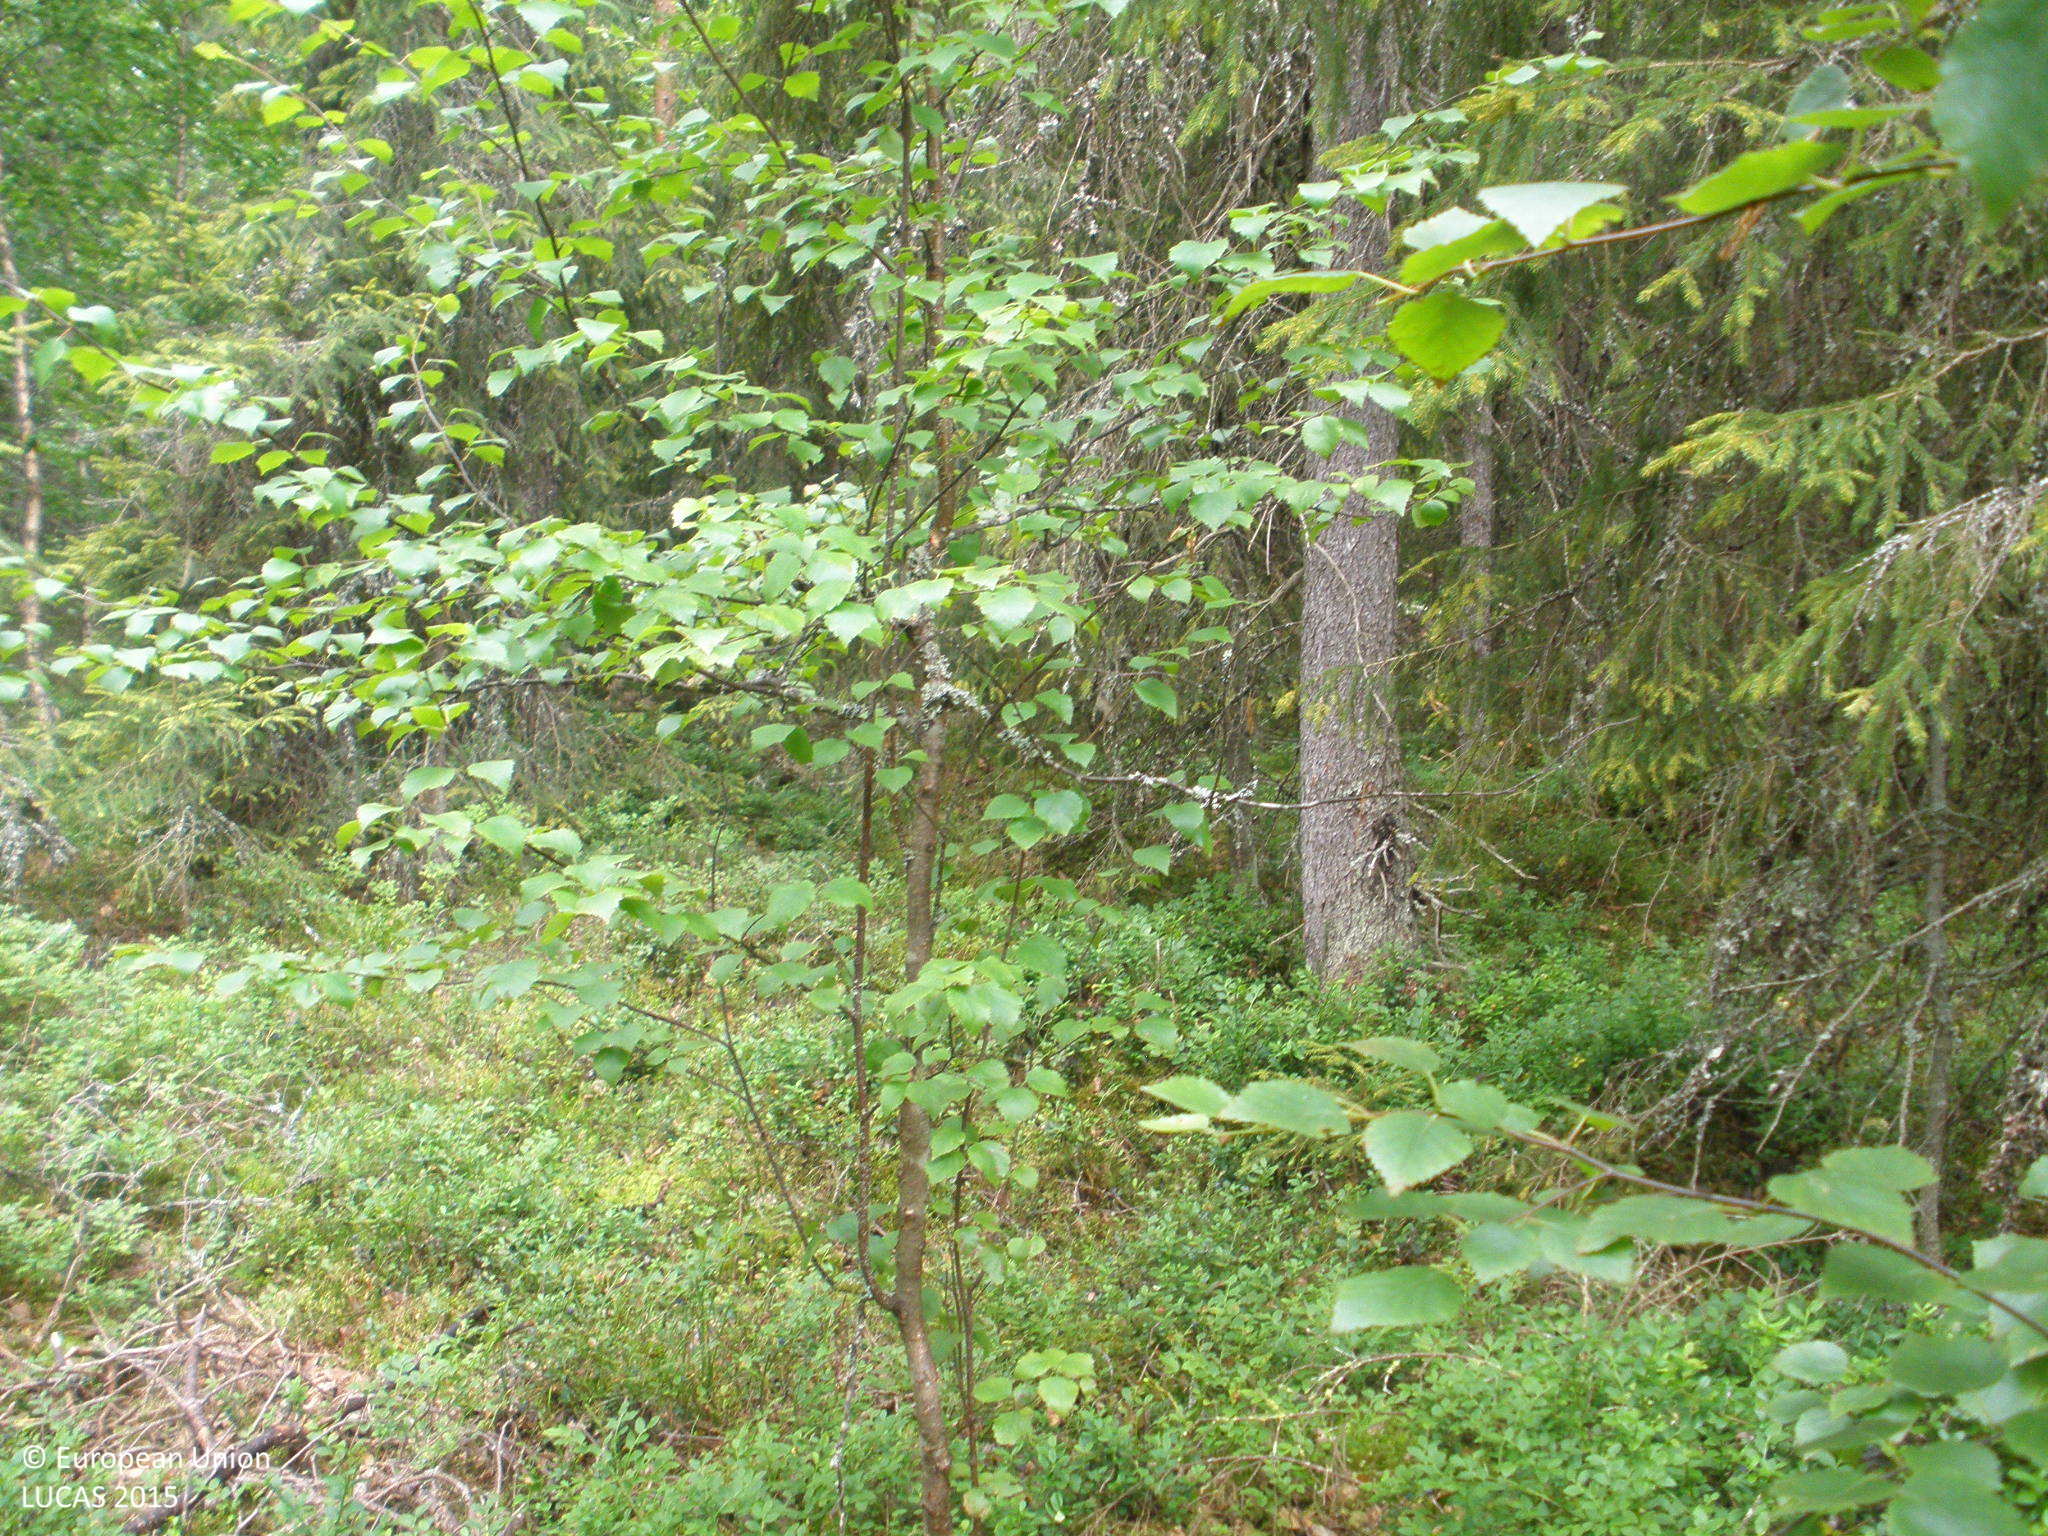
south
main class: Woodland
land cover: Pine dominated mixed woodland
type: boreal forest
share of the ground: > 75 %
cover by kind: coniferous forest trees 60 %, broadleaved forest trees 25 %, lichens and mosses 10 %, herbaceous plants 5 %
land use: Forestry
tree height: > 5 m
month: July
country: FI
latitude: 61.1676
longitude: 25.2302
